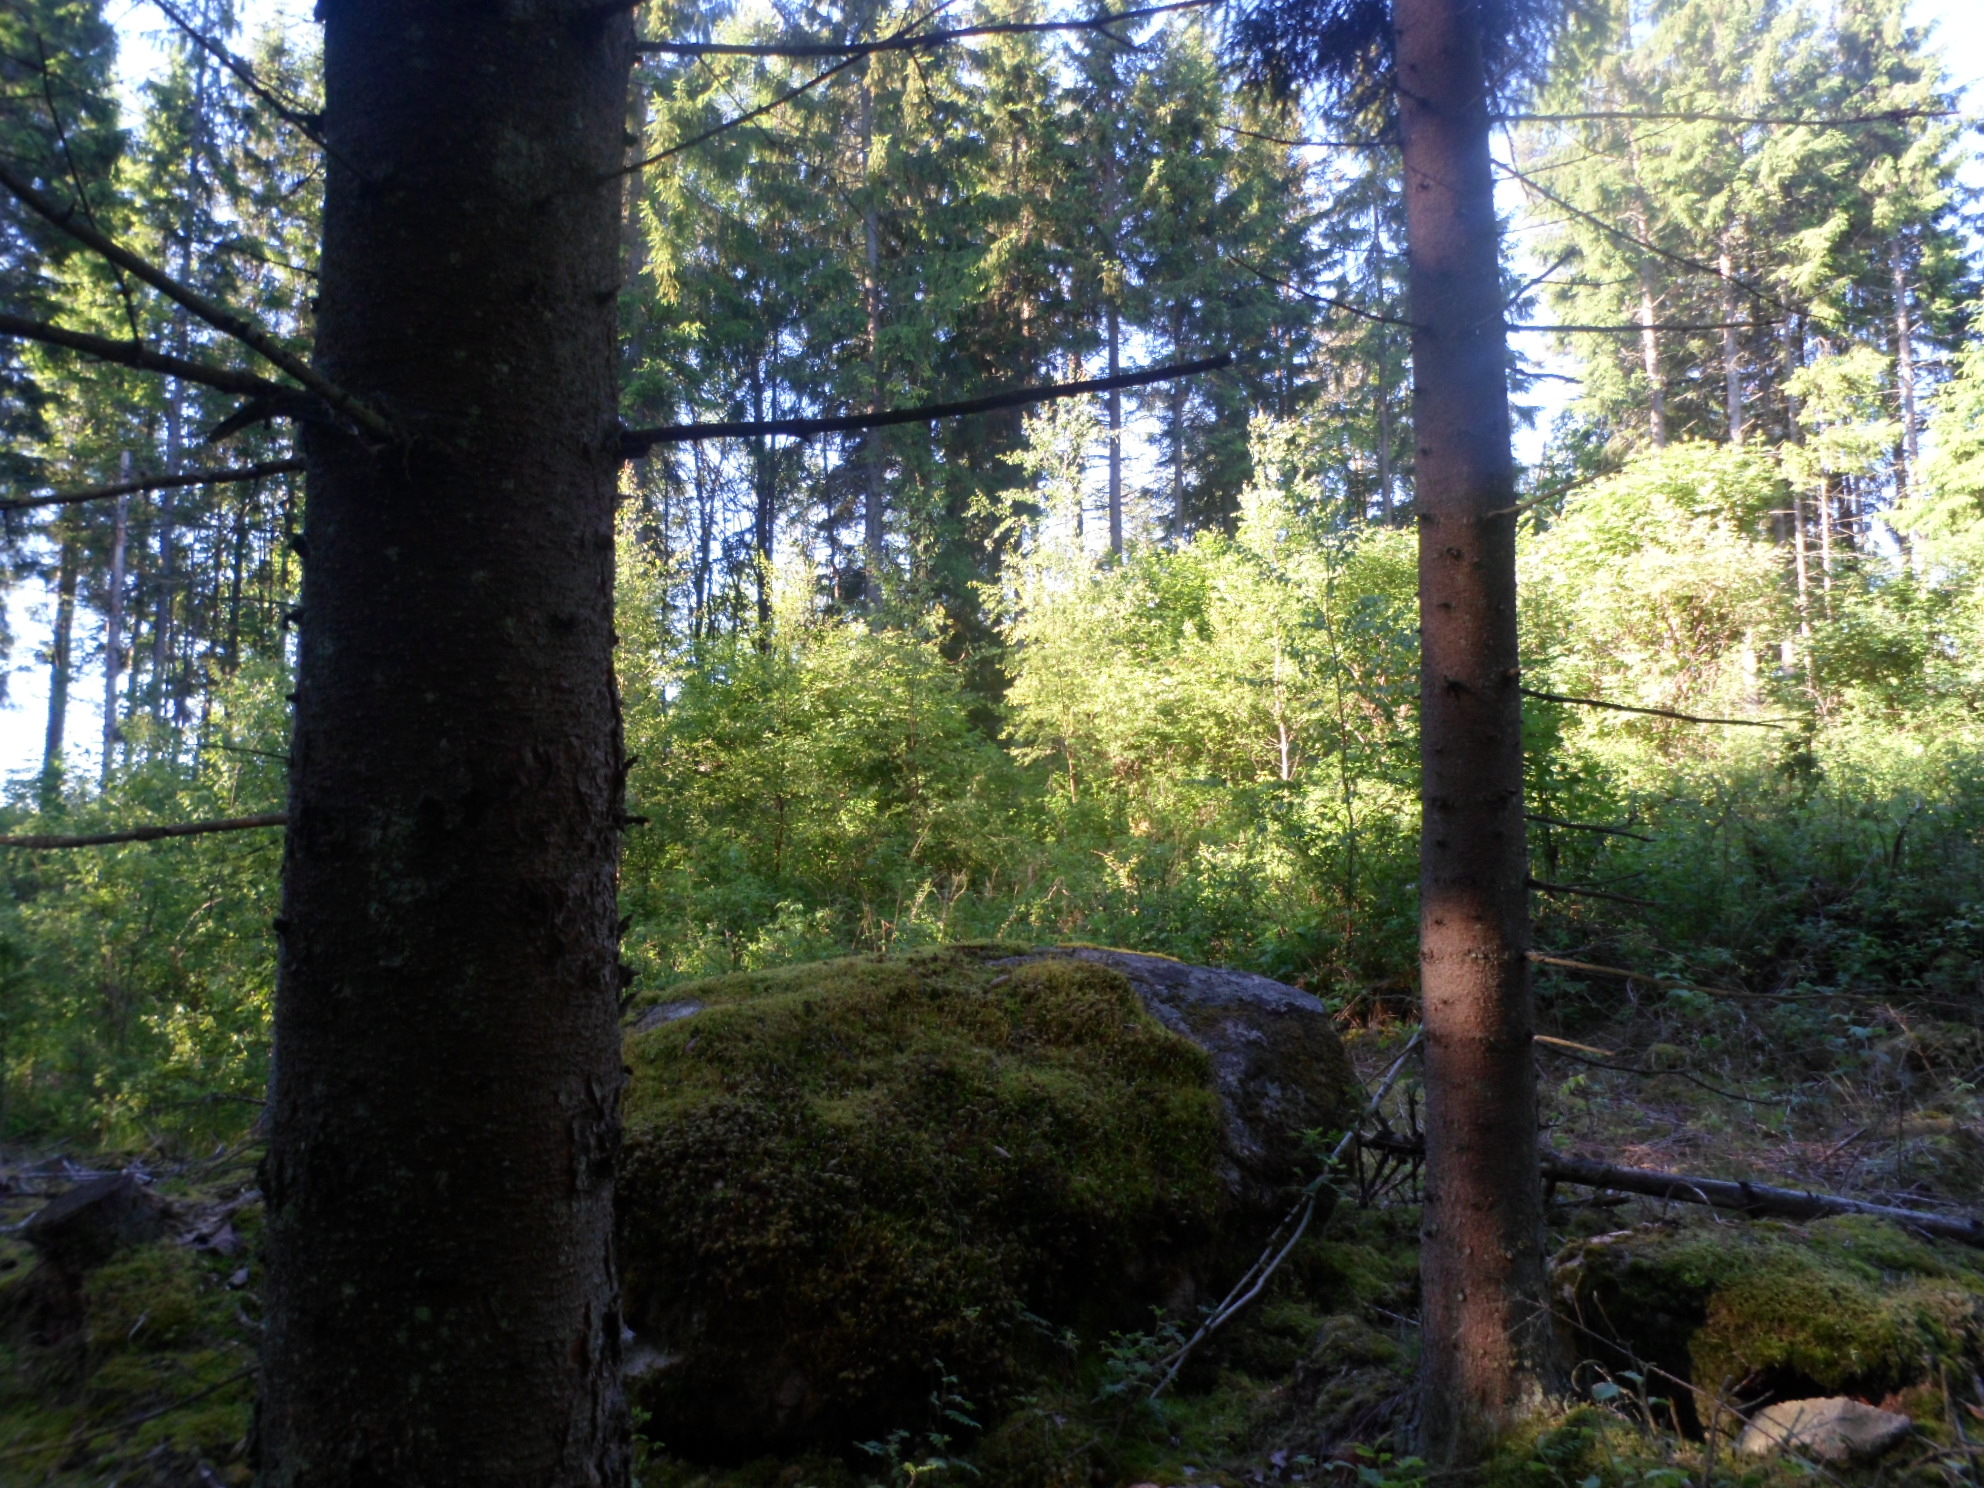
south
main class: Woodland
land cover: Spruce dominated coniferous woodland
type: boreal forest
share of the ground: 50 - 75 %
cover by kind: coniferous forest trees 55 %, lichens and mosses 20 %, broadleaved forest trees 10 %, shrubs 10 %, herbaceous plants 5 %
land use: Forestry
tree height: > 5 m
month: July
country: SE
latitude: 57.2428
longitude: 14.5200
